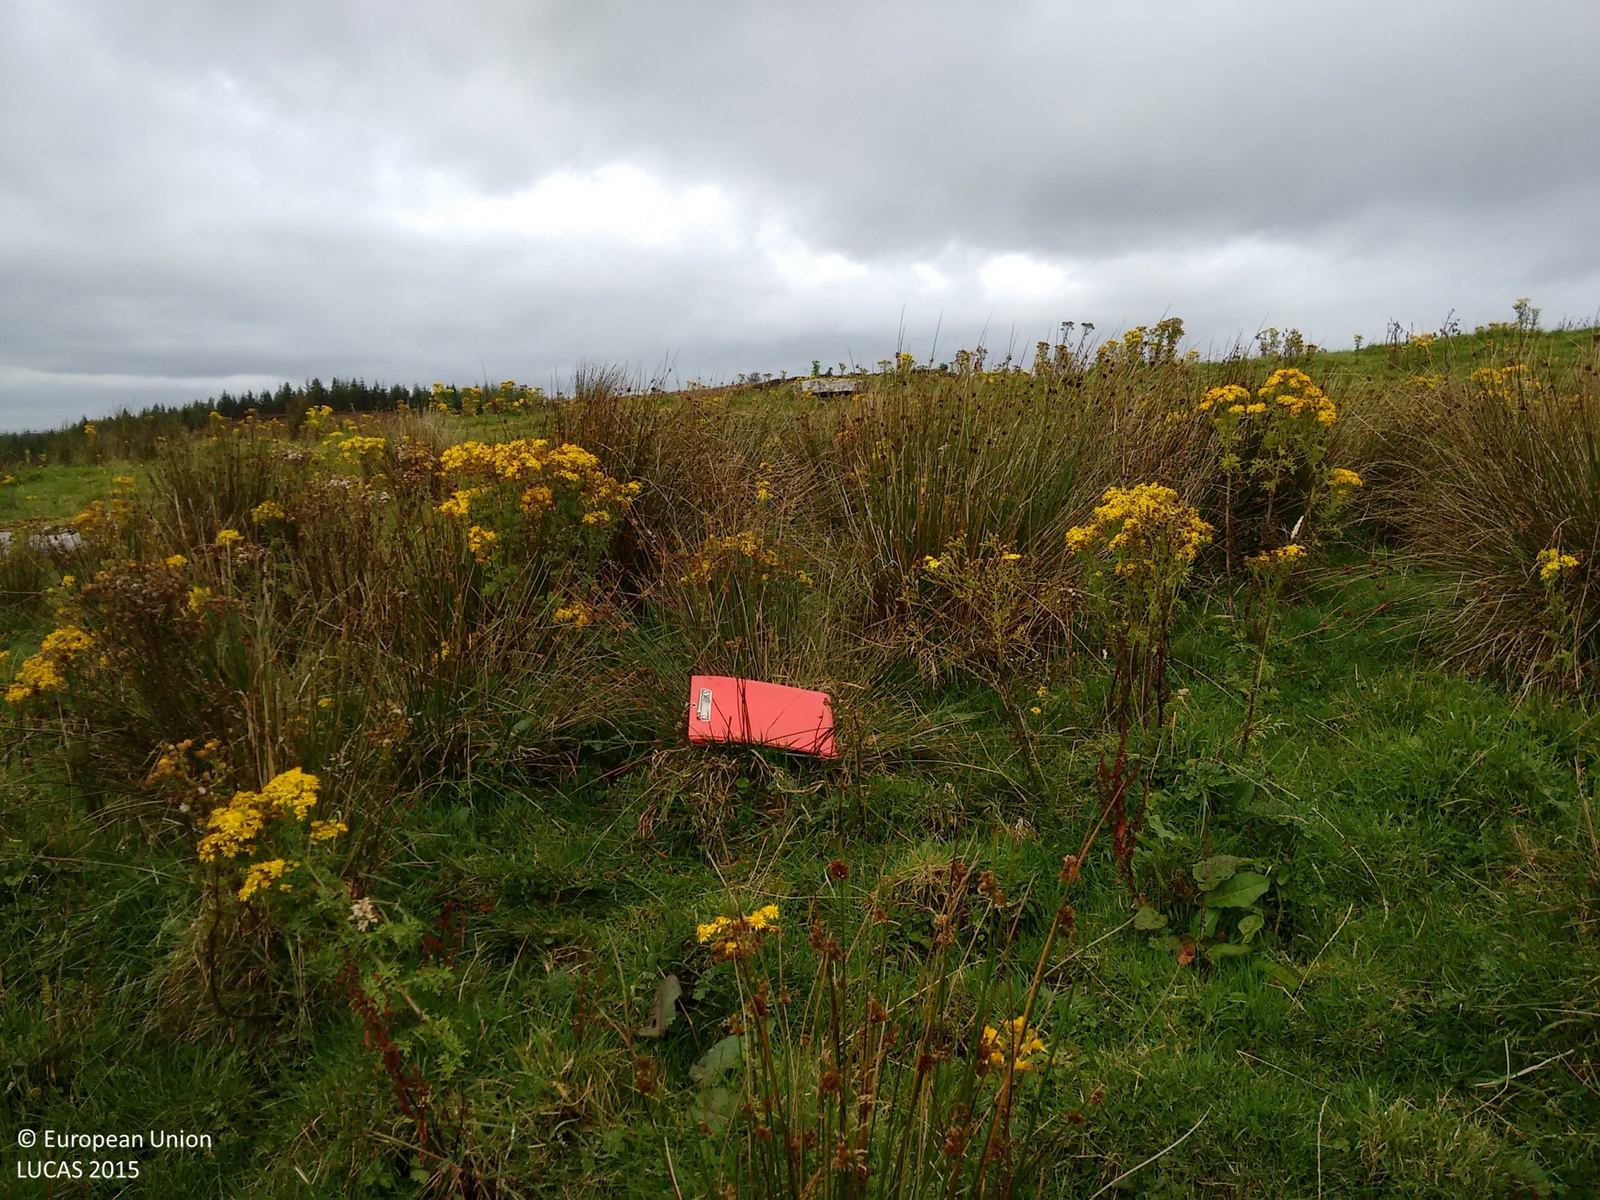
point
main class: Grassland
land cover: Grassland without tree/shrub cover
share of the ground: > 75 %
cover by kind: herbaceous plants 100 %
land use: Agriculture (excluding fallow land and kitchen gardens)
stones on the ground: < 10 %
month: September
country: IE
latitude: 53.8997
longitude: -8.8492
